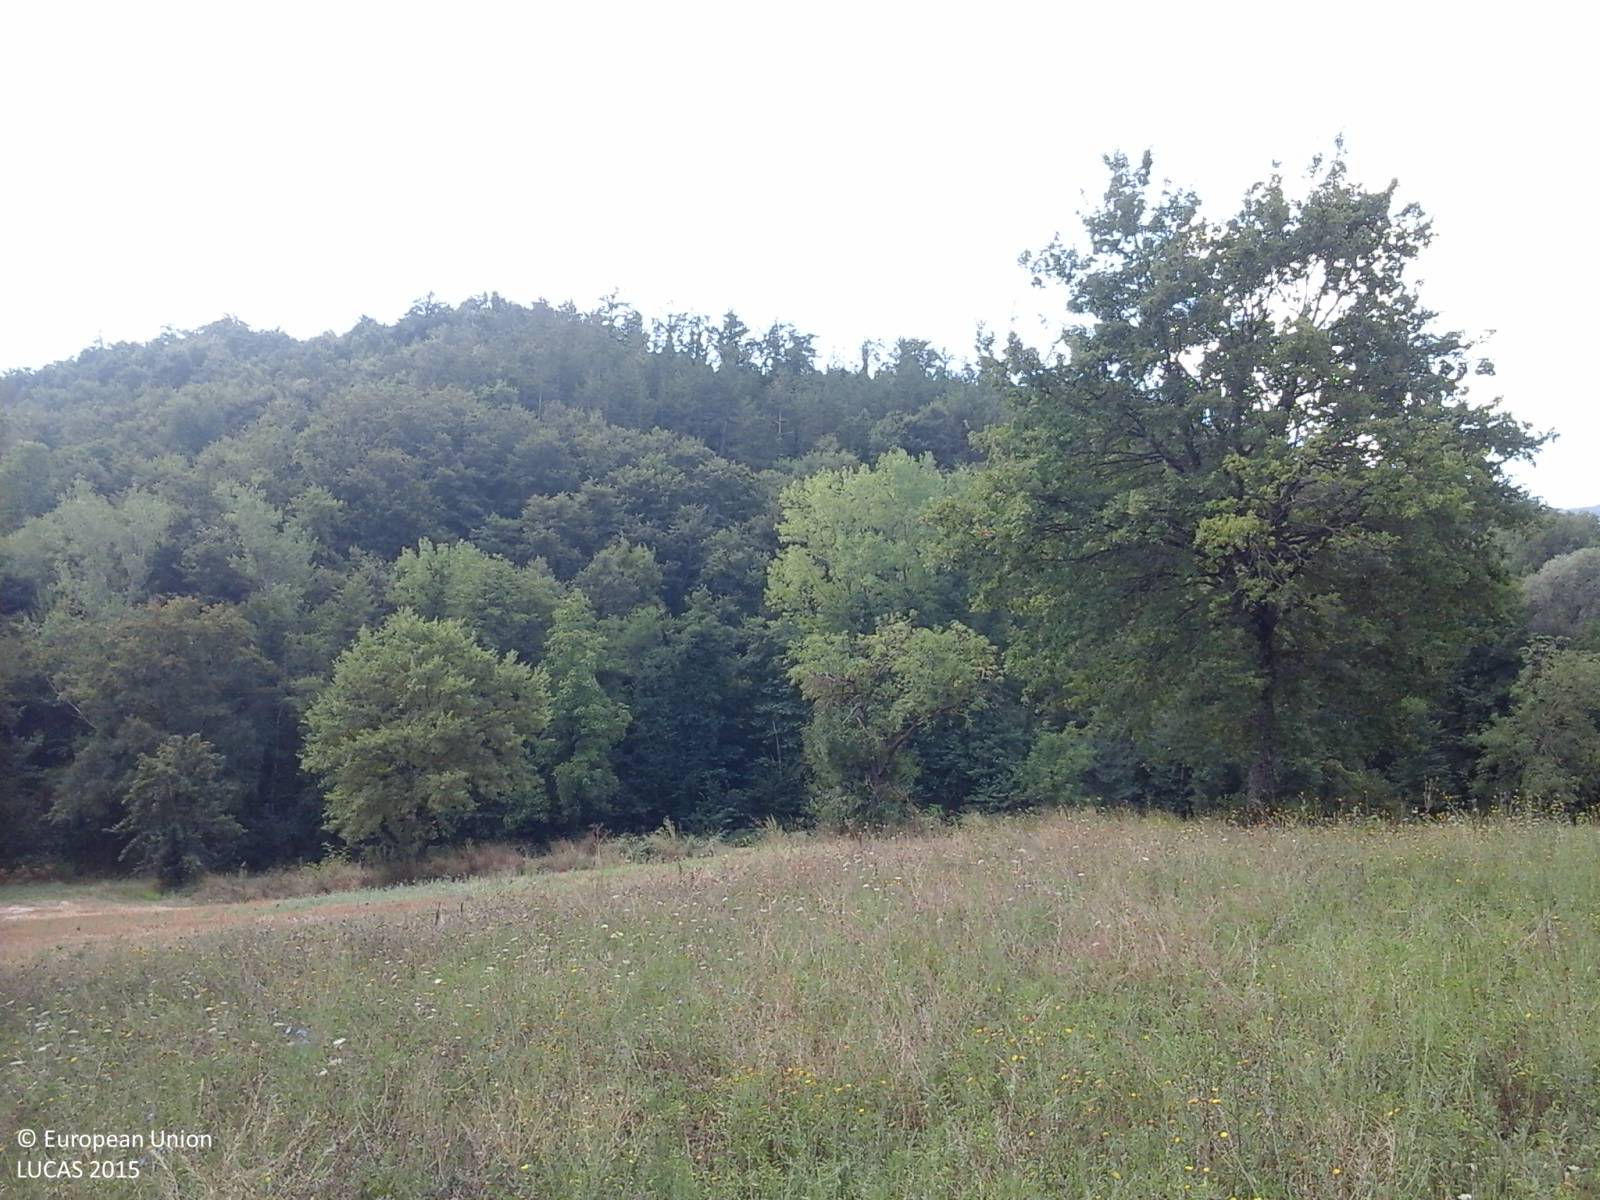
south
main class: Cropland
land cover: Temporary grasslands
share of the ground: > 75 %
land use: Agriculture (excluding fallow land and kitchen gardens)
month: August
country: IT
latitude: 43.4629
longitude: 12.1078
